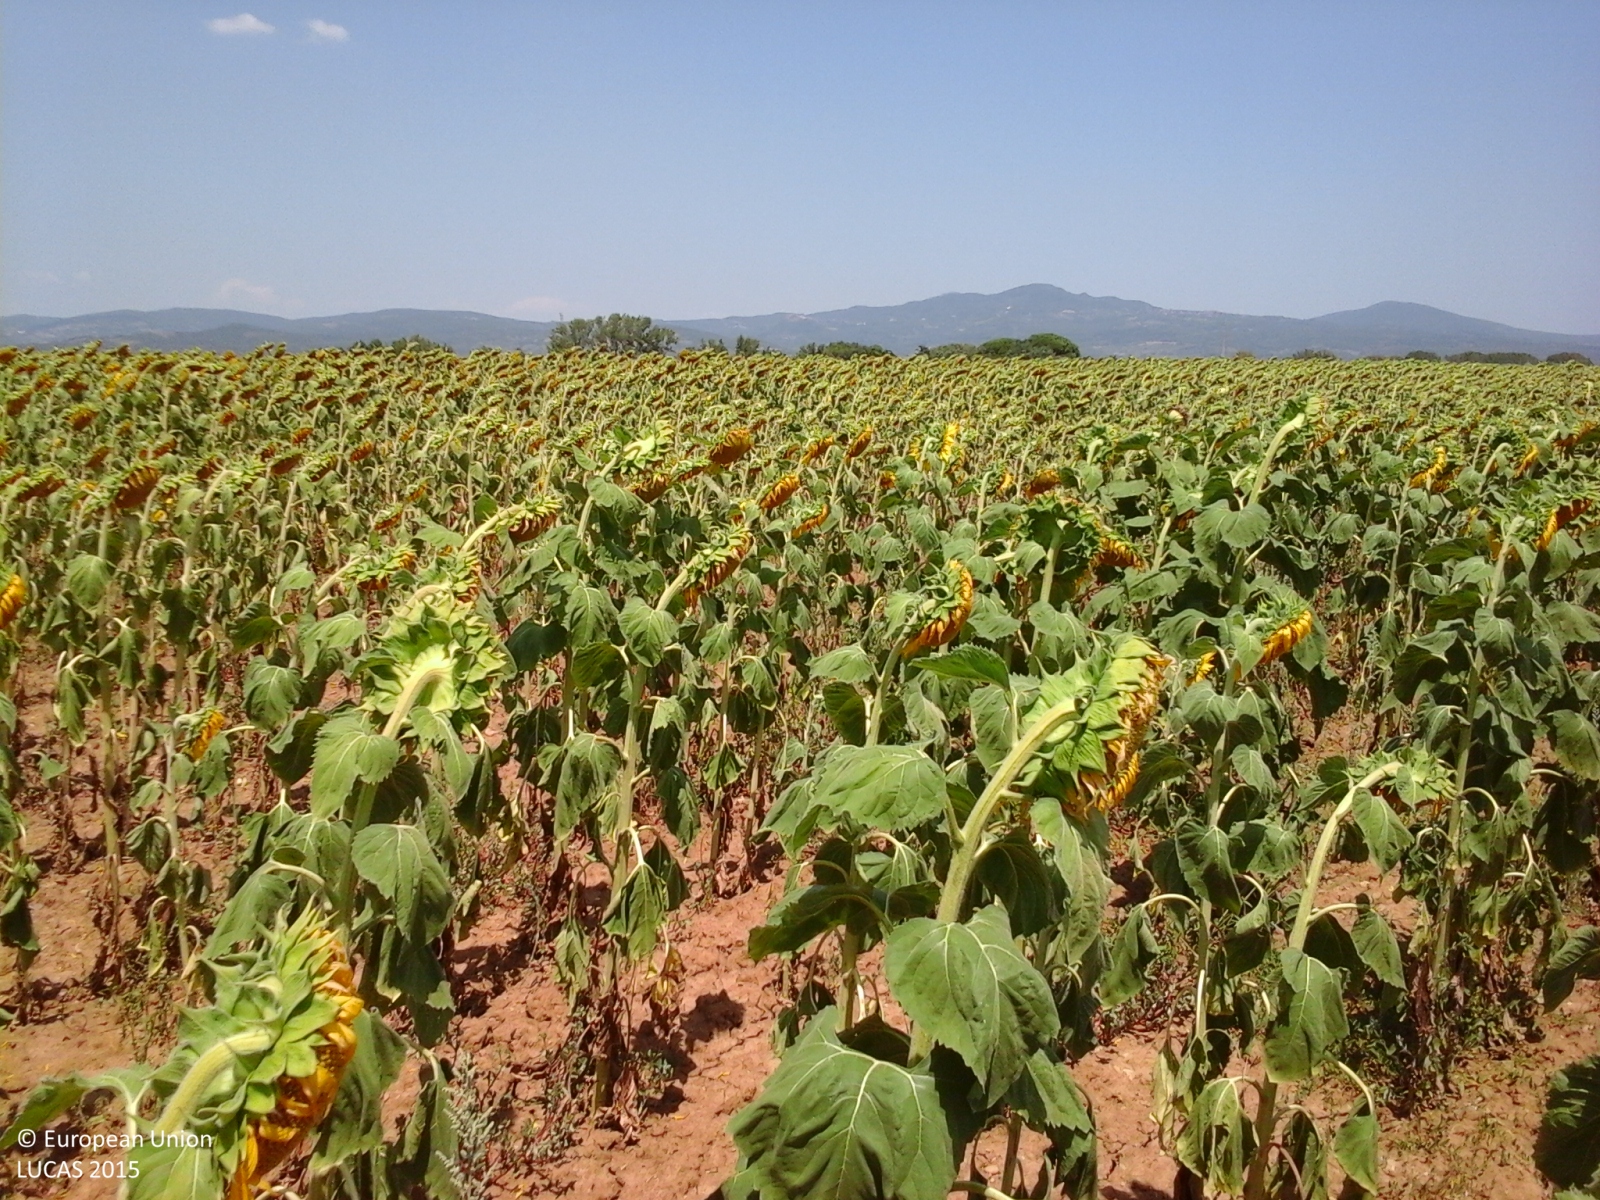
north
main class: Cropland
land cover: Sunflower
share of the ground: > 75 %
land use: Agriculture (excluding fallow land and kitchen gardens)
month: July
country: IT
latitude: 42.9374
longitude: 11.0628
